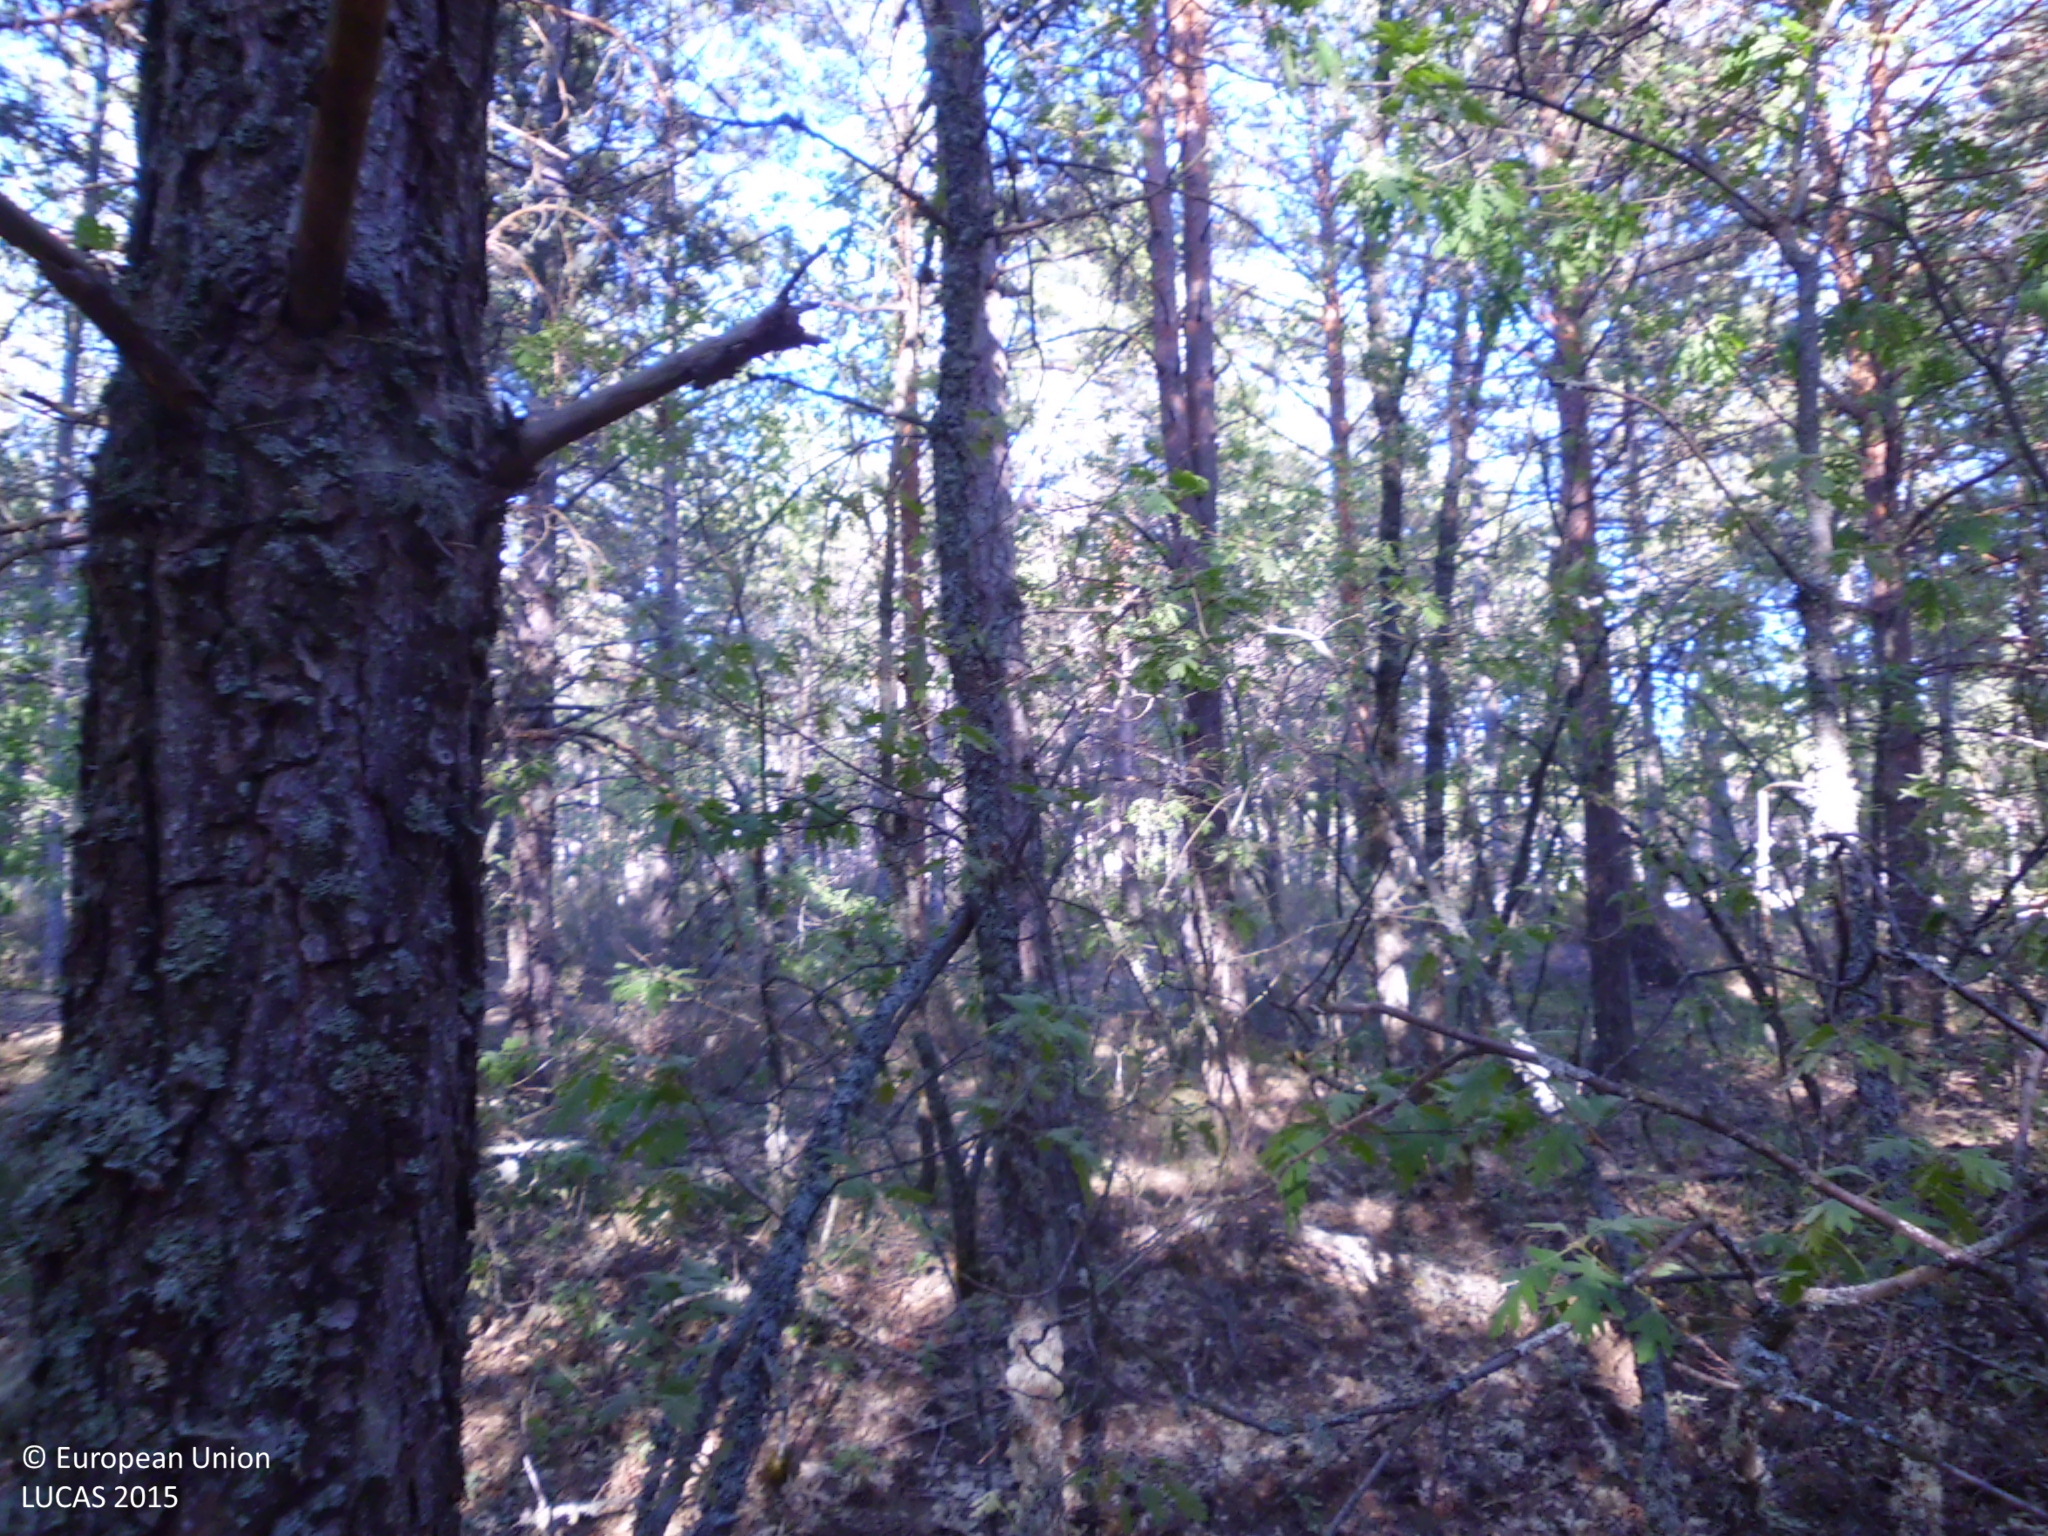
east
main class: Woodland
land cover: Pine dominated coniferous woodland
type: coniferous forest of the mediterranean region
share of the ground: > 75 %
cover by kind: coniferous forest trees 100 %
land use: Forestry
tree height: > 5 m
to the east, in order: Pine dominated coniferous woodland
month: May
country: ES
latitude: 42.6866
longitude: -4.8643
